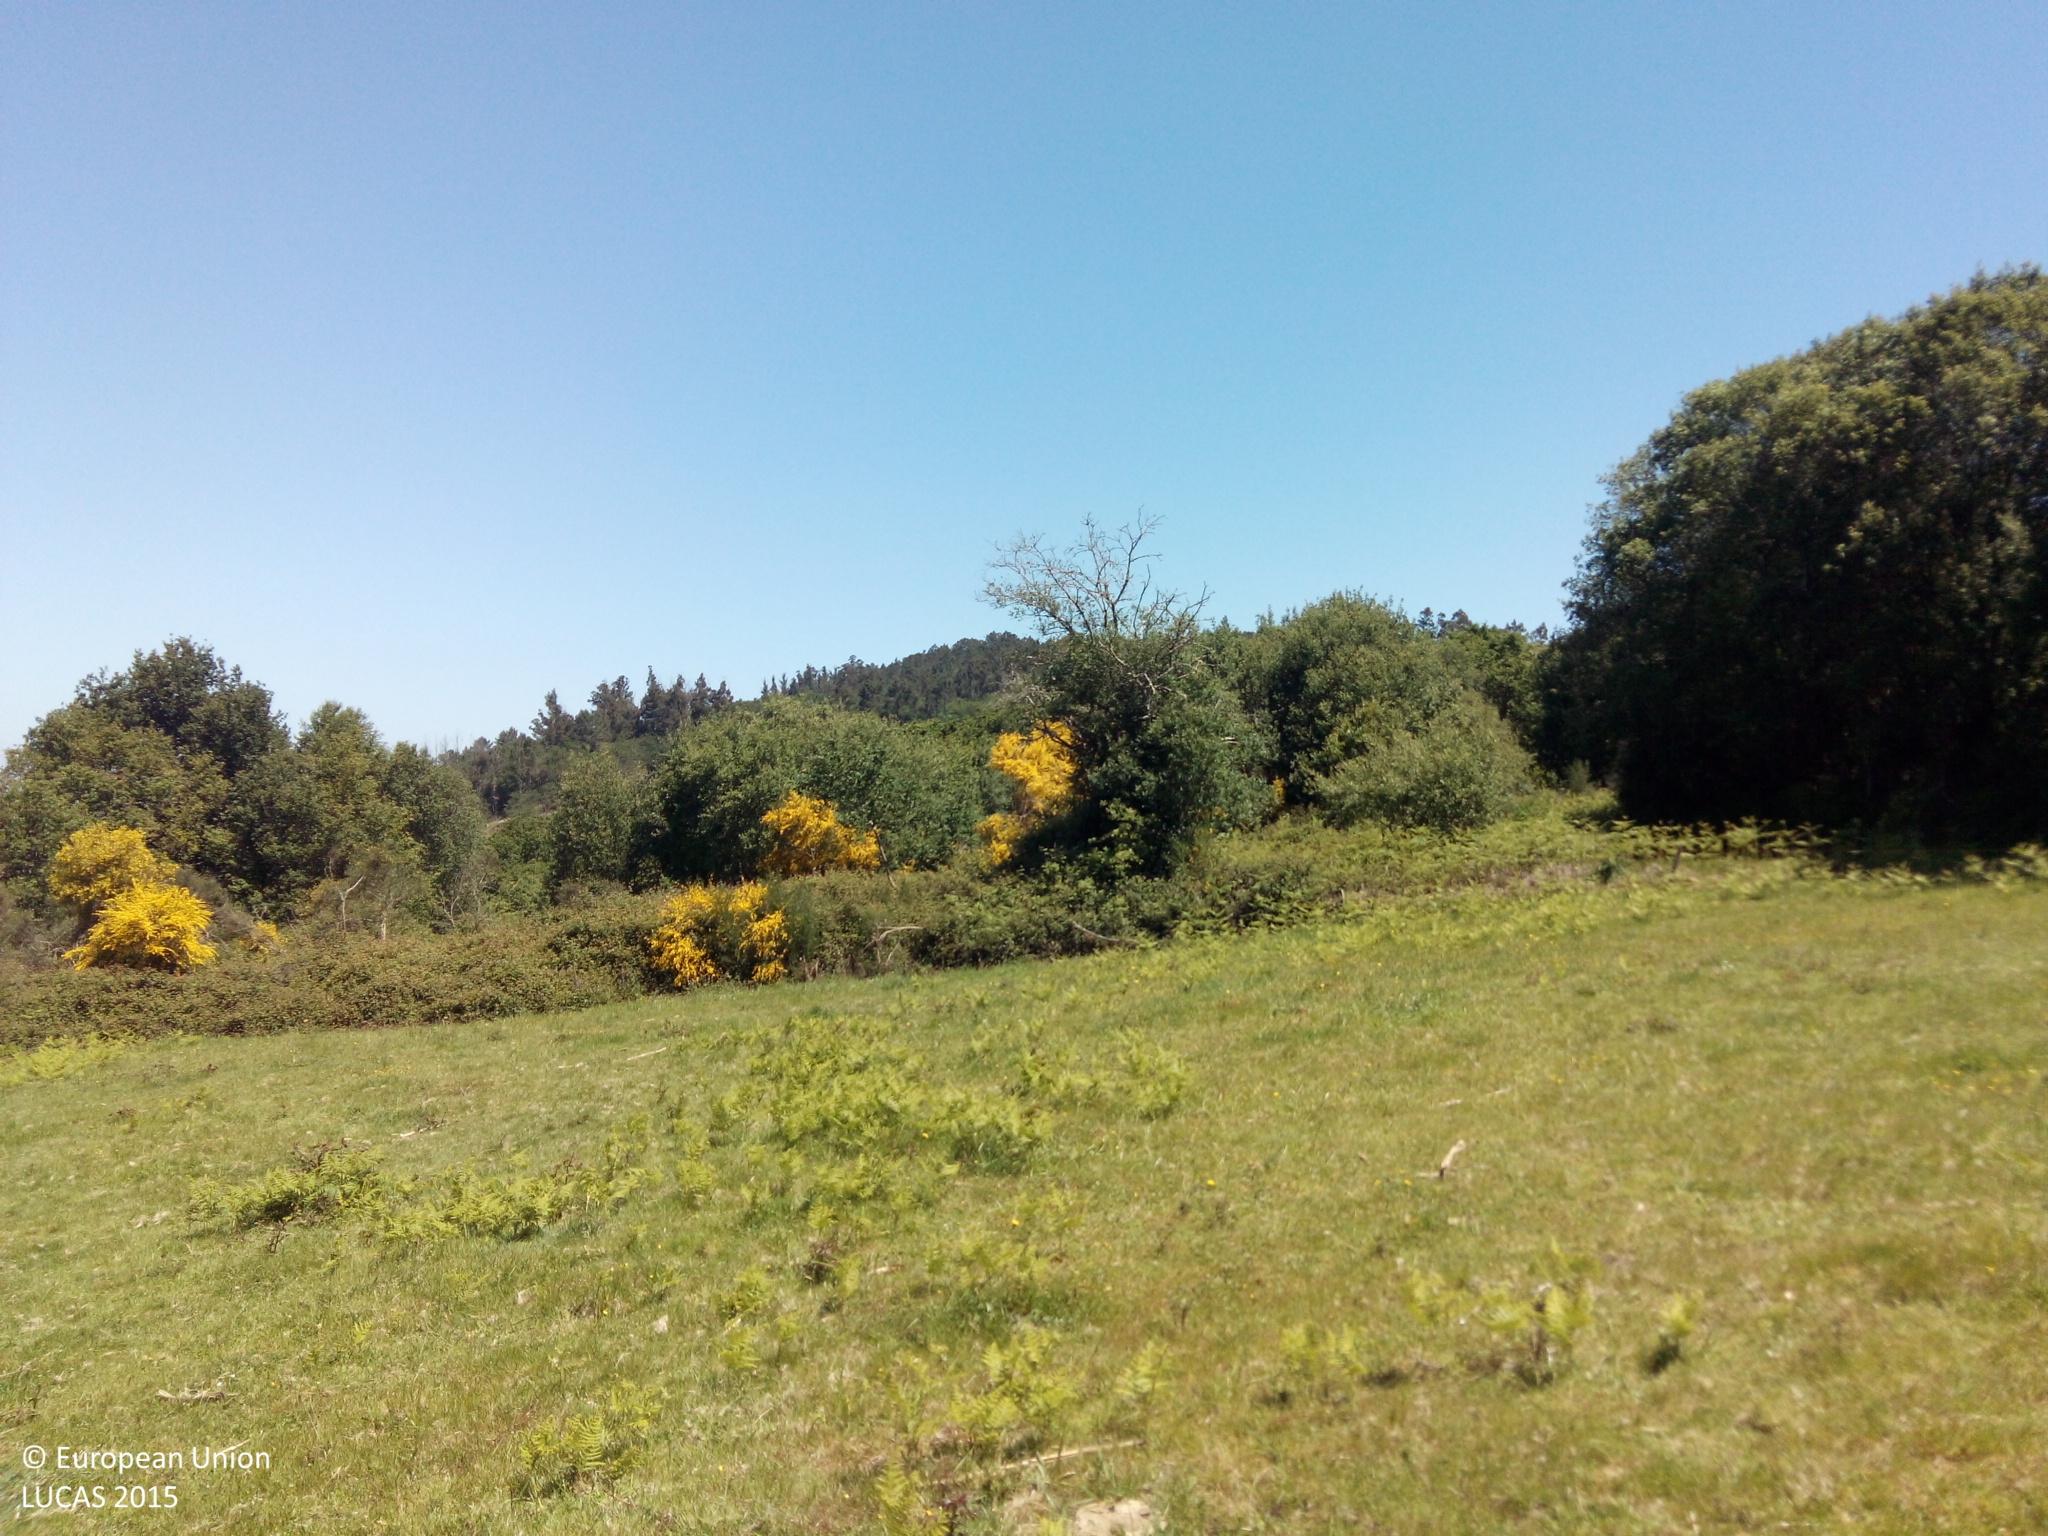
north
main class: Grassland
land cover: Grassland without tree/shrub cover
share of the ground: > 75 %
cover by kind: herbaceous plants 100 %
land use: Agriculture (excluding fallow land and kitchen gardens)
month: May
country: ES
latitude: 42.6451
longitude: -8.4298
